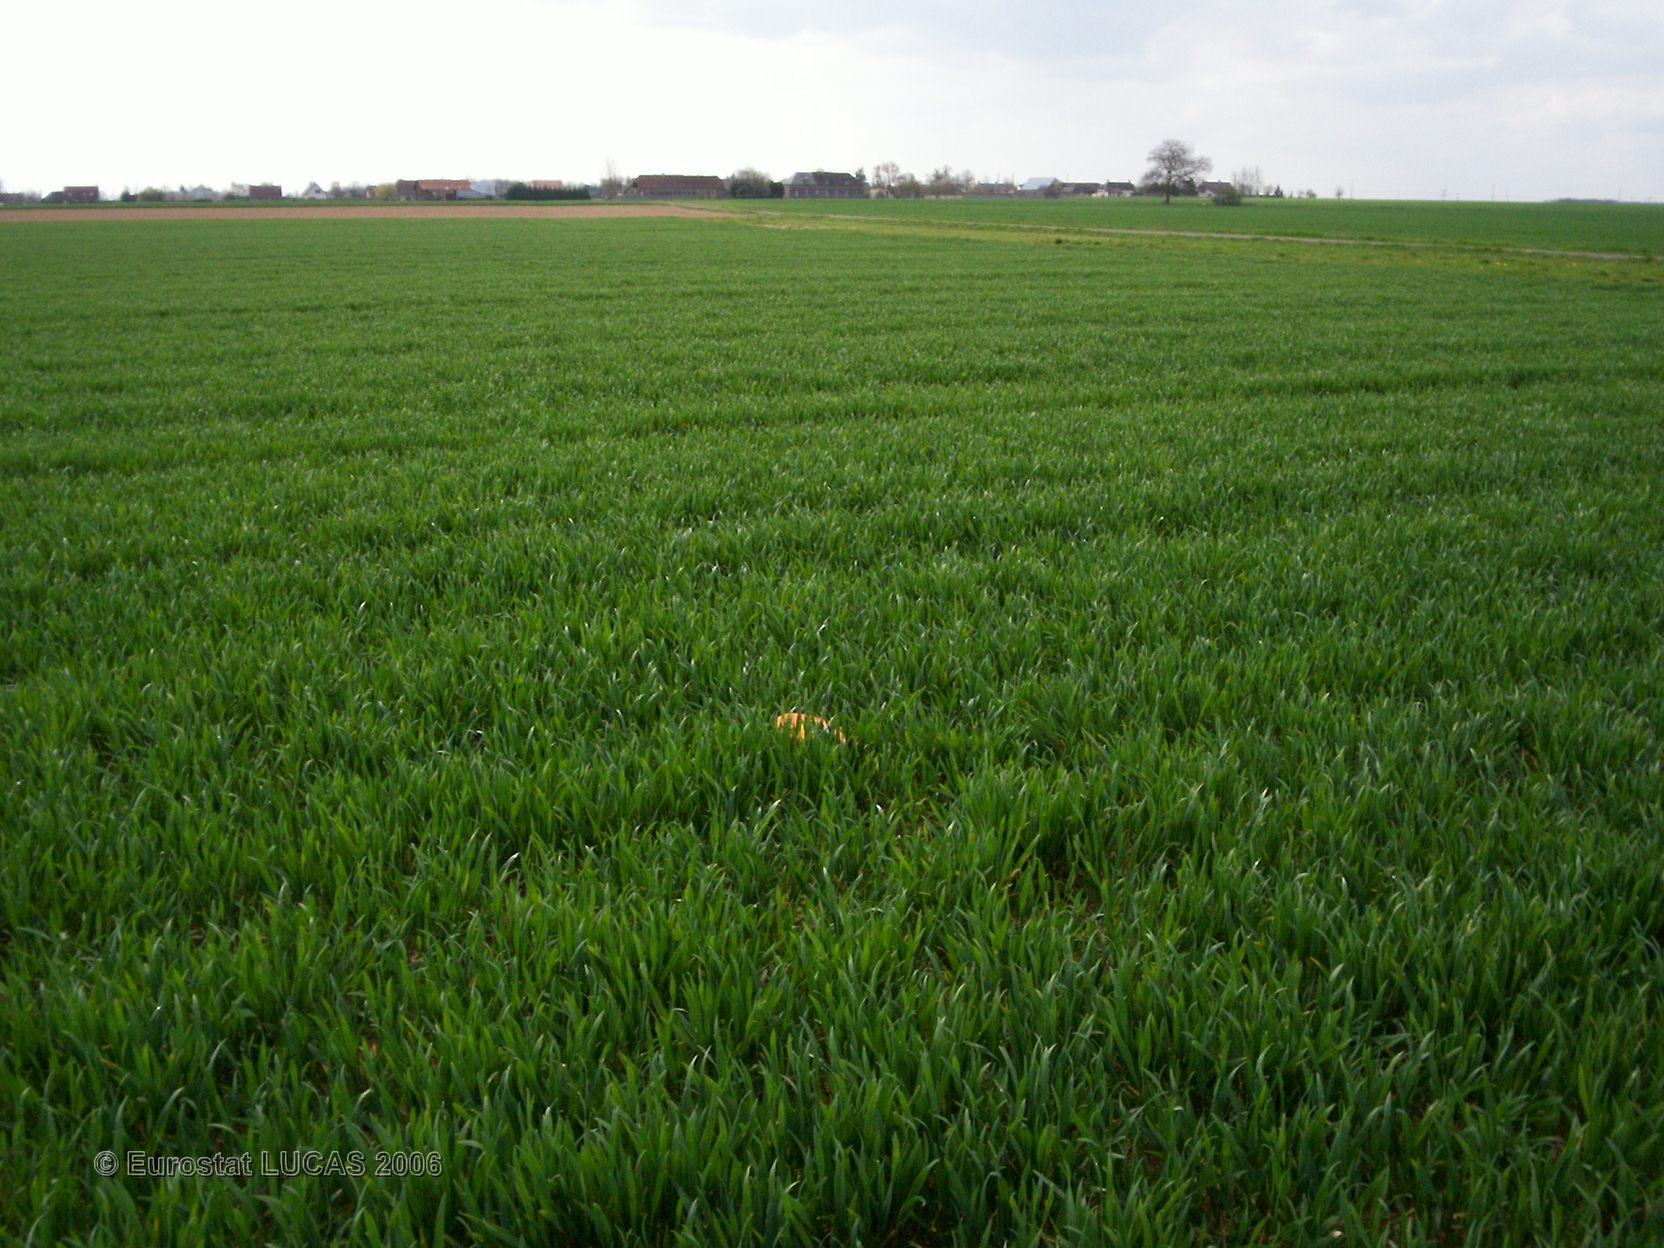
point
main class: Cropland
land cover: Common wheat
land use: Agriculture (excluding fallow land and kitchen gardens)
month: April
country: FR
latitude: 49.0530
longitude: 1.0434
